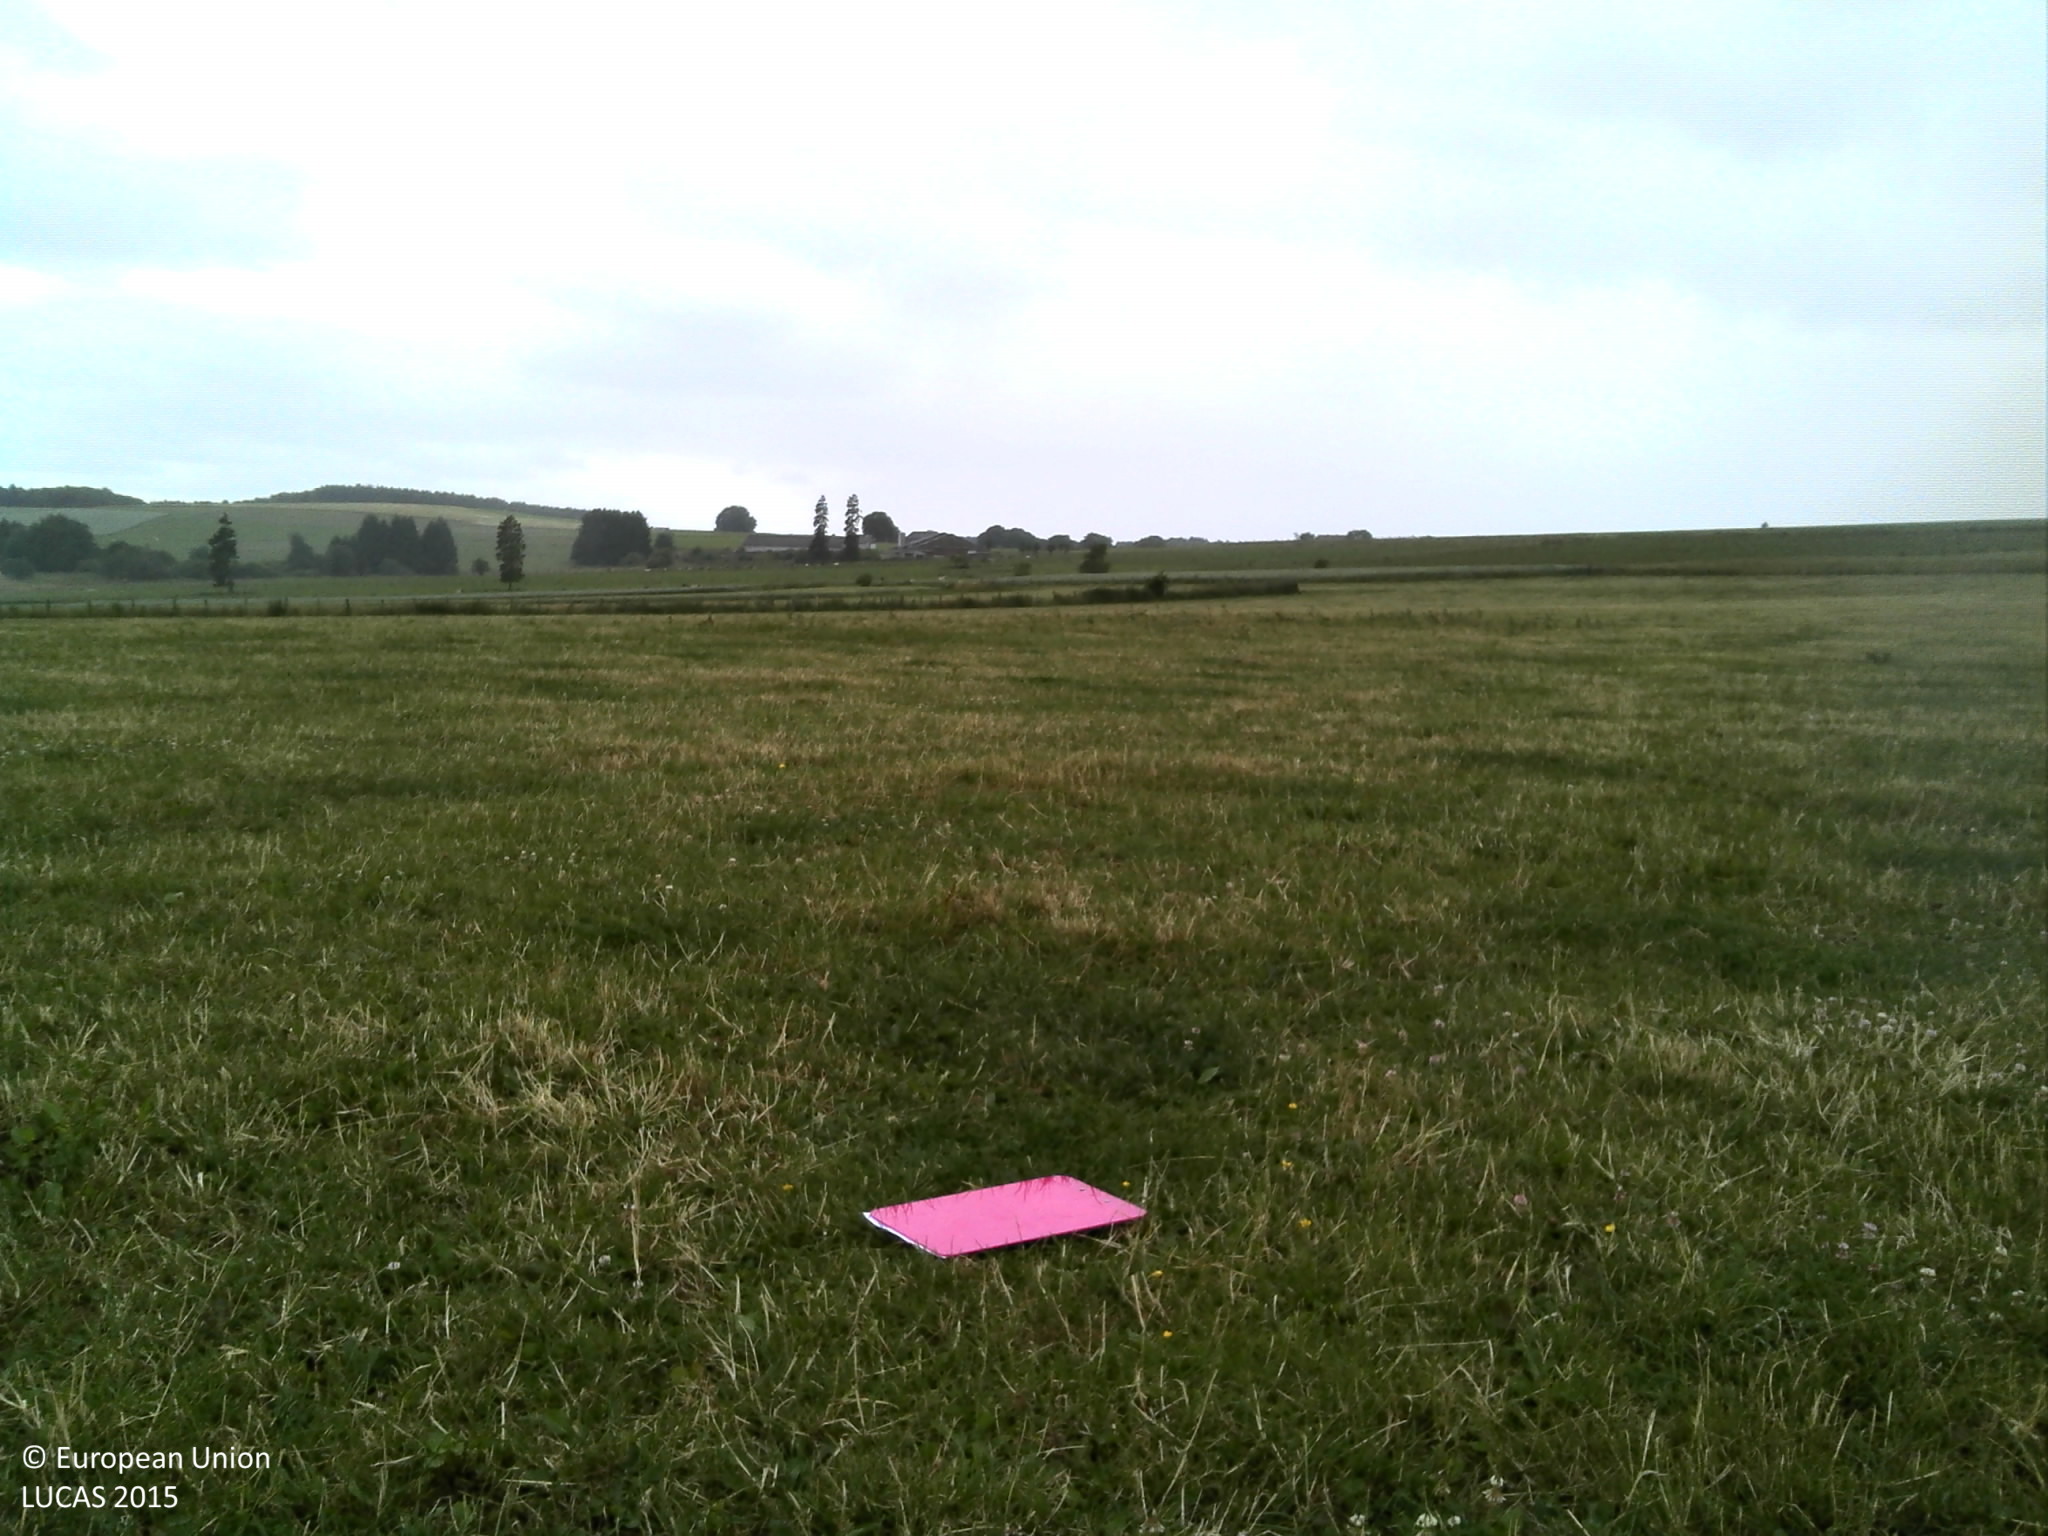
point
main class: Grassland
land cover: Grassland without tree/shrub cover
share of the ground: > 75 %
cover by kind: herbaceous plants 100 %
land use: Agriculture (excluding fallow land and kitchen gardens)
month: July
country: LU
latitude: 50.0937
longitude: 5.9313
